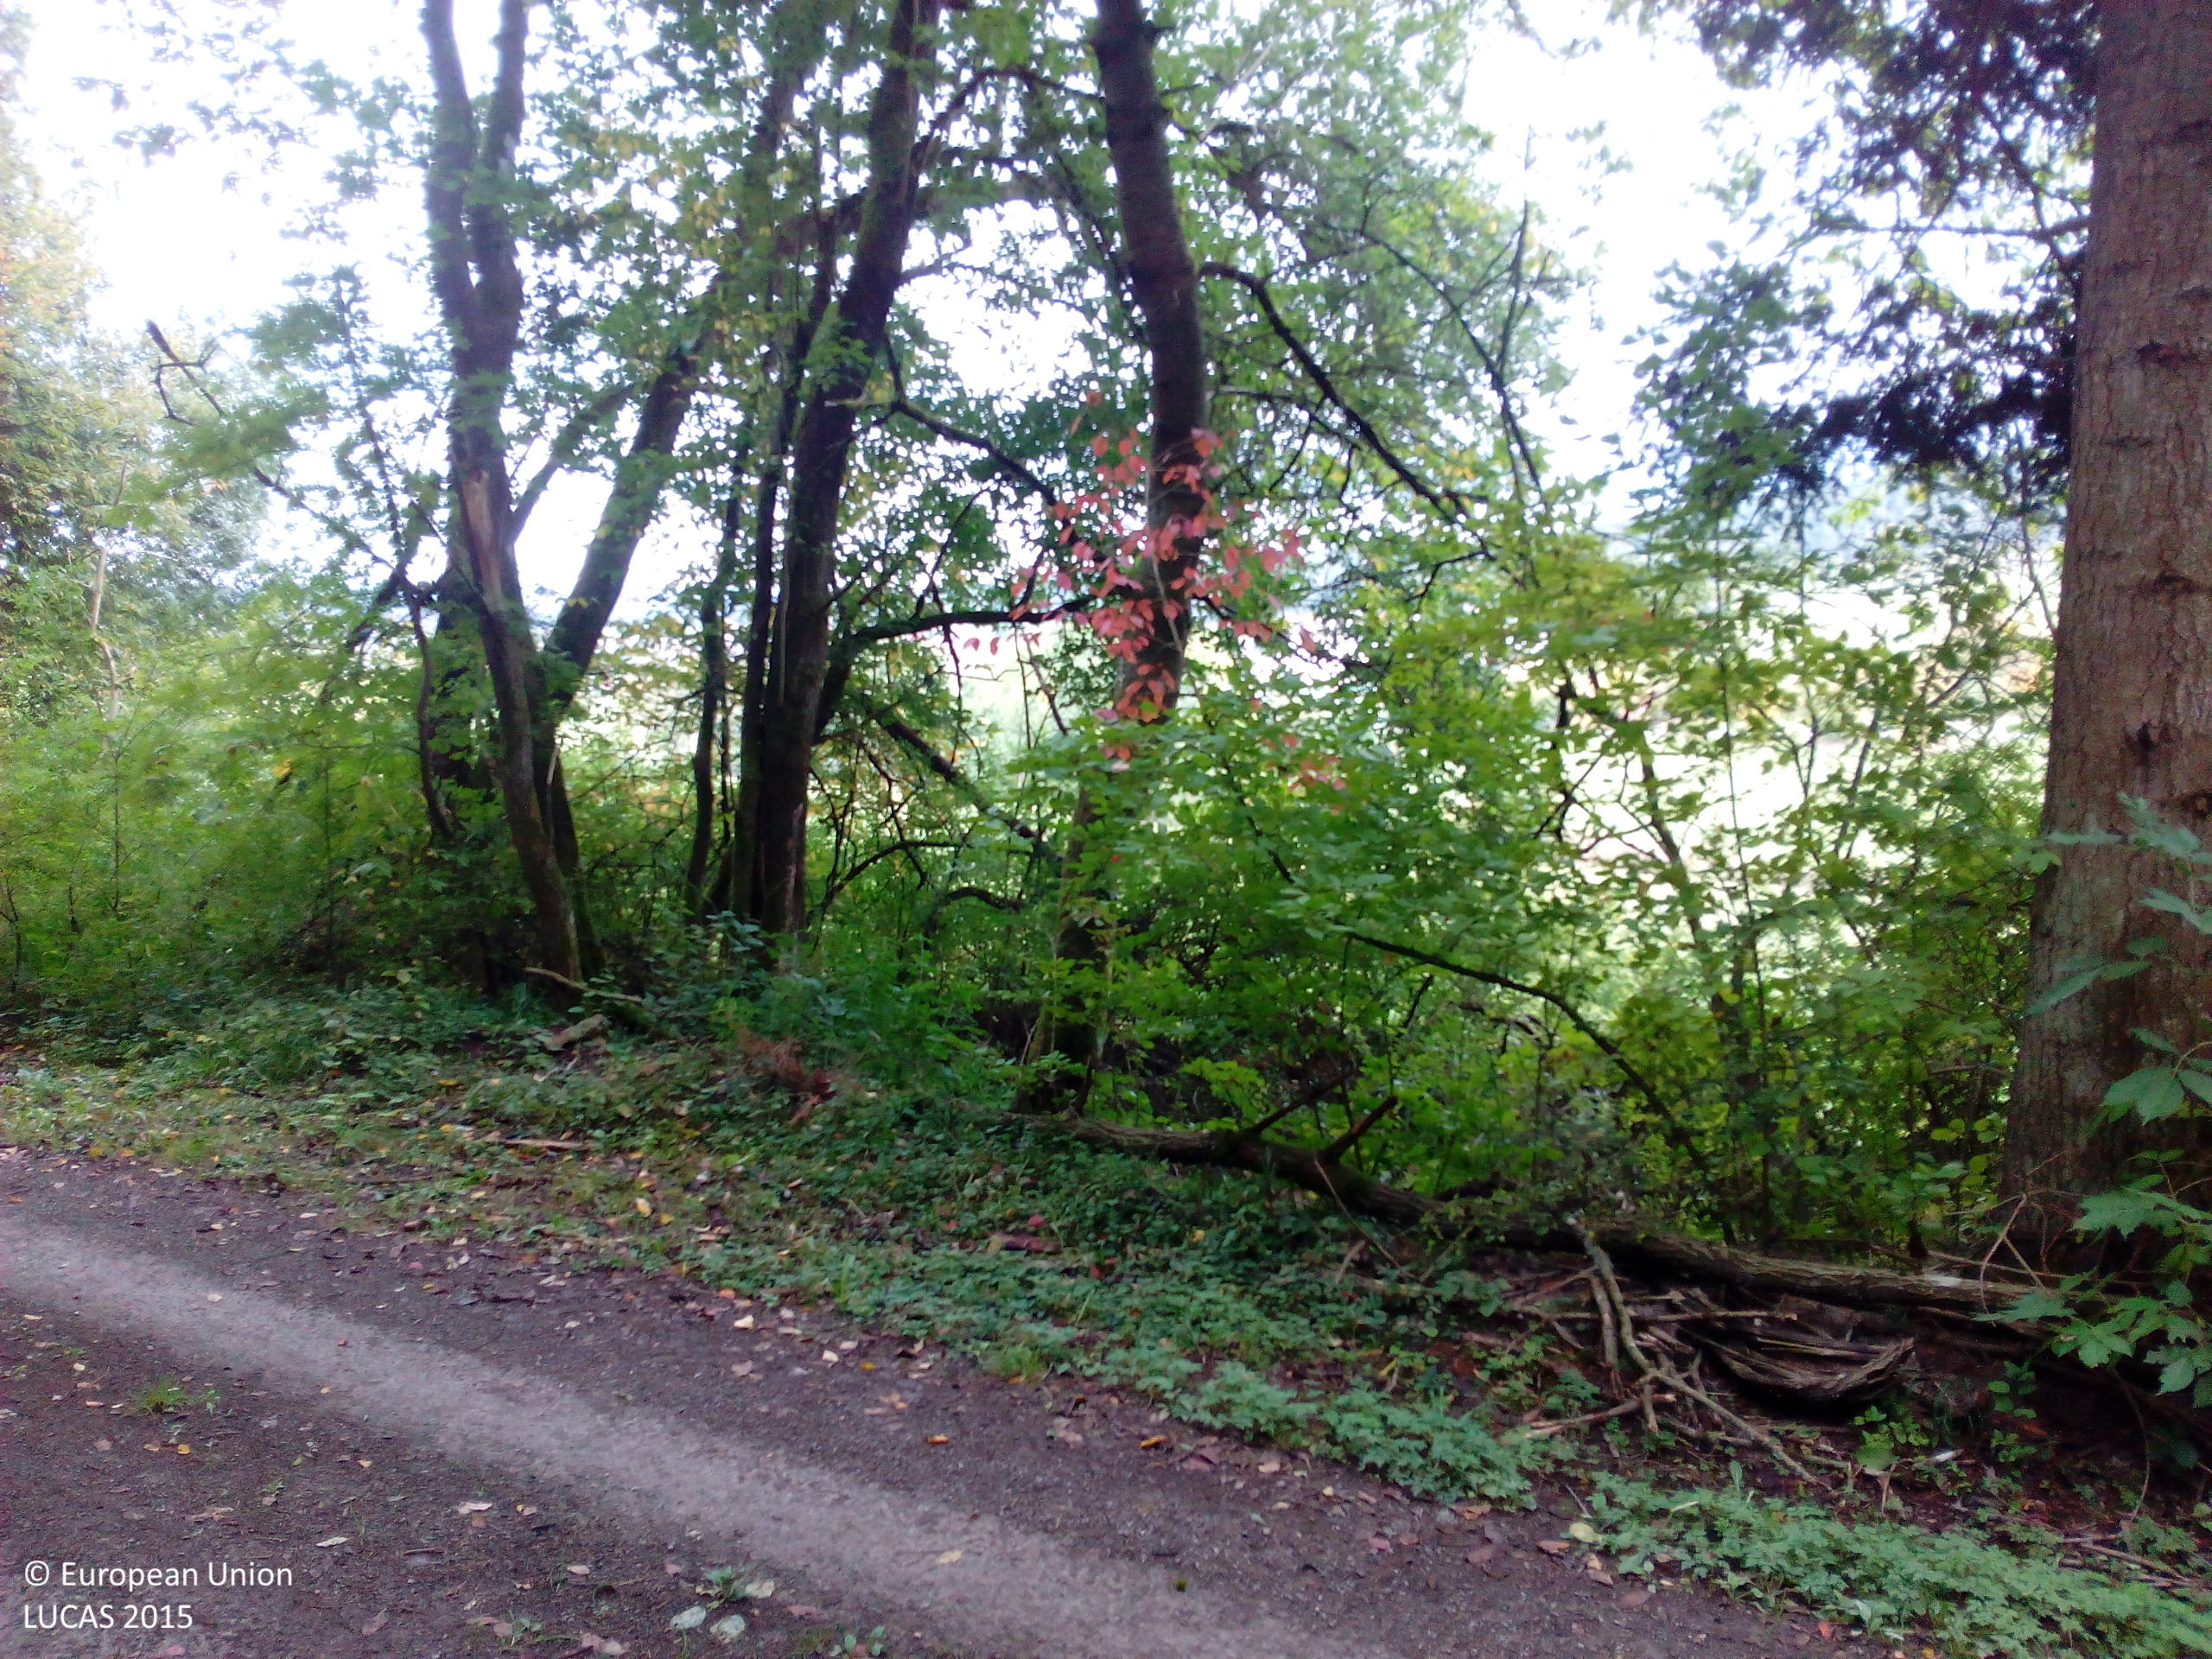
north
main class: Woodland
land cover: Other mixed woodland
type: hemiboreal forest and nemoral coniferous forest and mixed broadleaved-coniferous forest
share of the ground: > 75 %
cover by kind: coniferous forest trees 50 %, broadleaved forest trees 40 %, shrubs 10 %
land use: Forestry
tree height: > 5 m
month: September
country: DE
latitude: 48.4664
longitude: 8.5806
